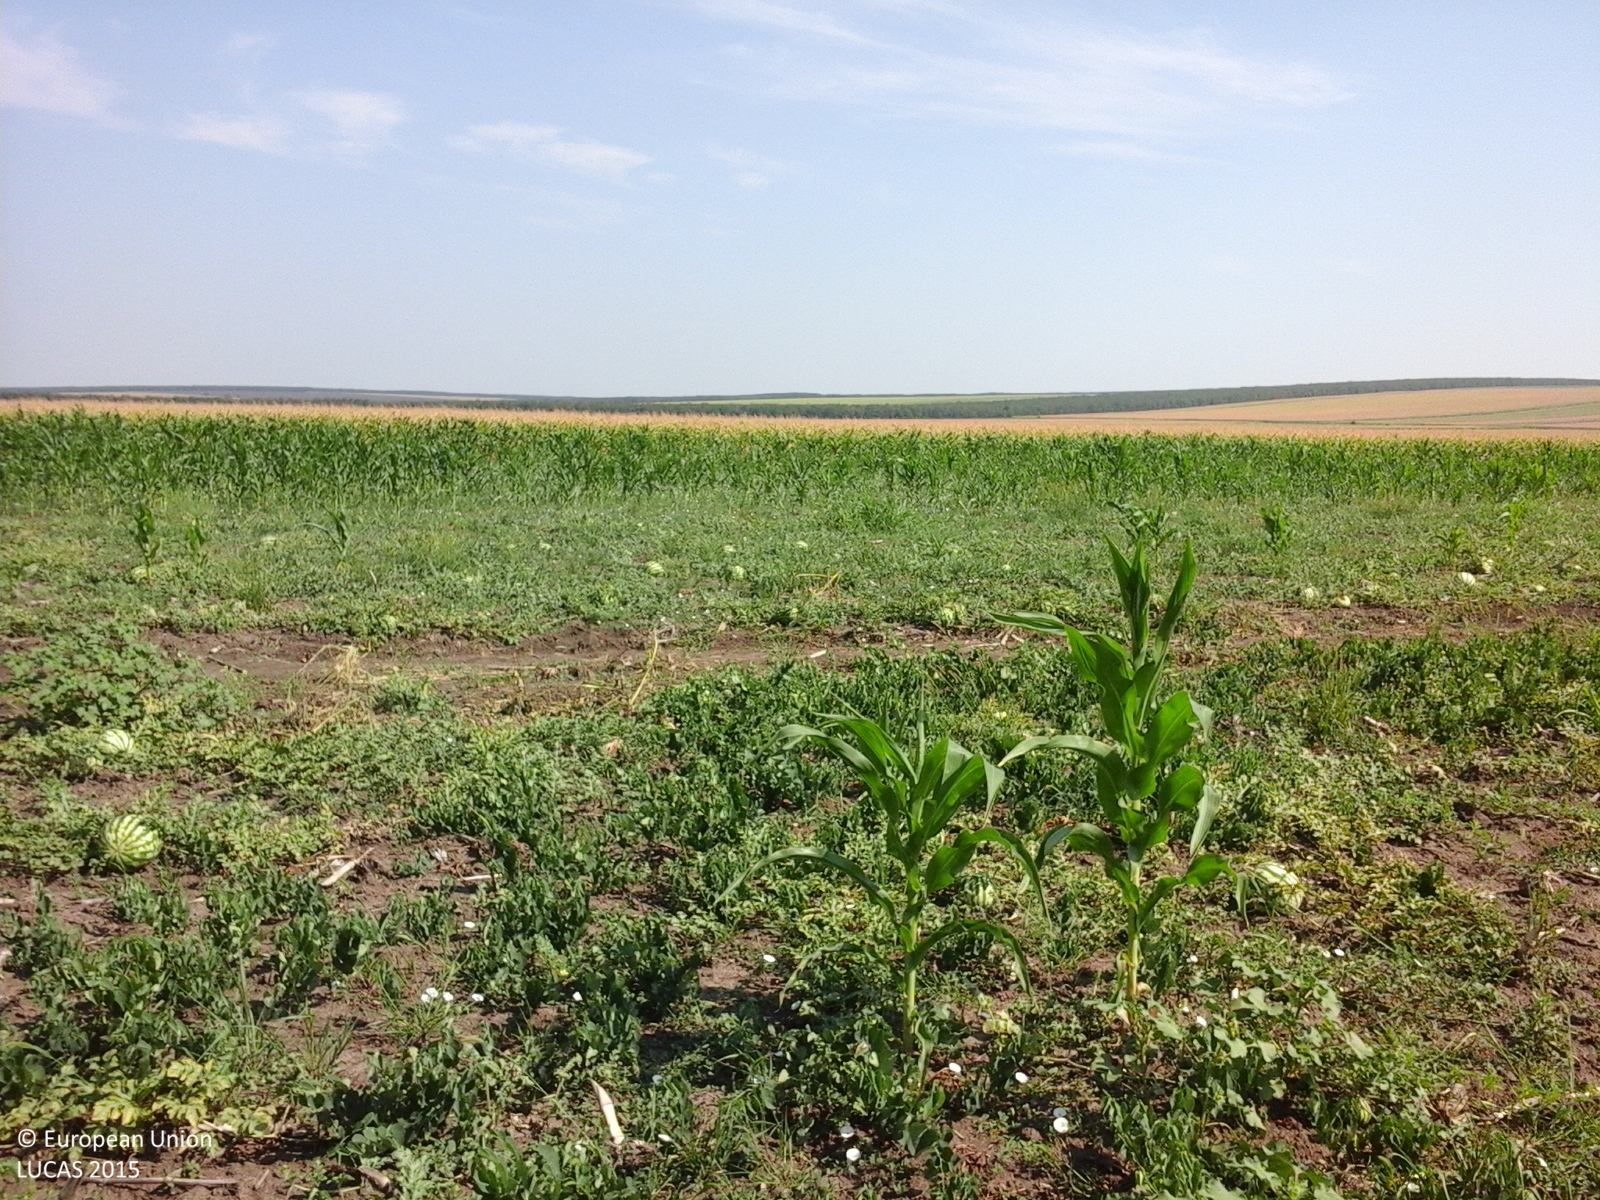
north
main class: Cropland
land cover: Maize
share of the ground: > 75 %
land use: Agriculture (excluding fallow land and kitchen gardens)
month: August
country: RO
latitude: 45.8430
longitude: 27.6603
